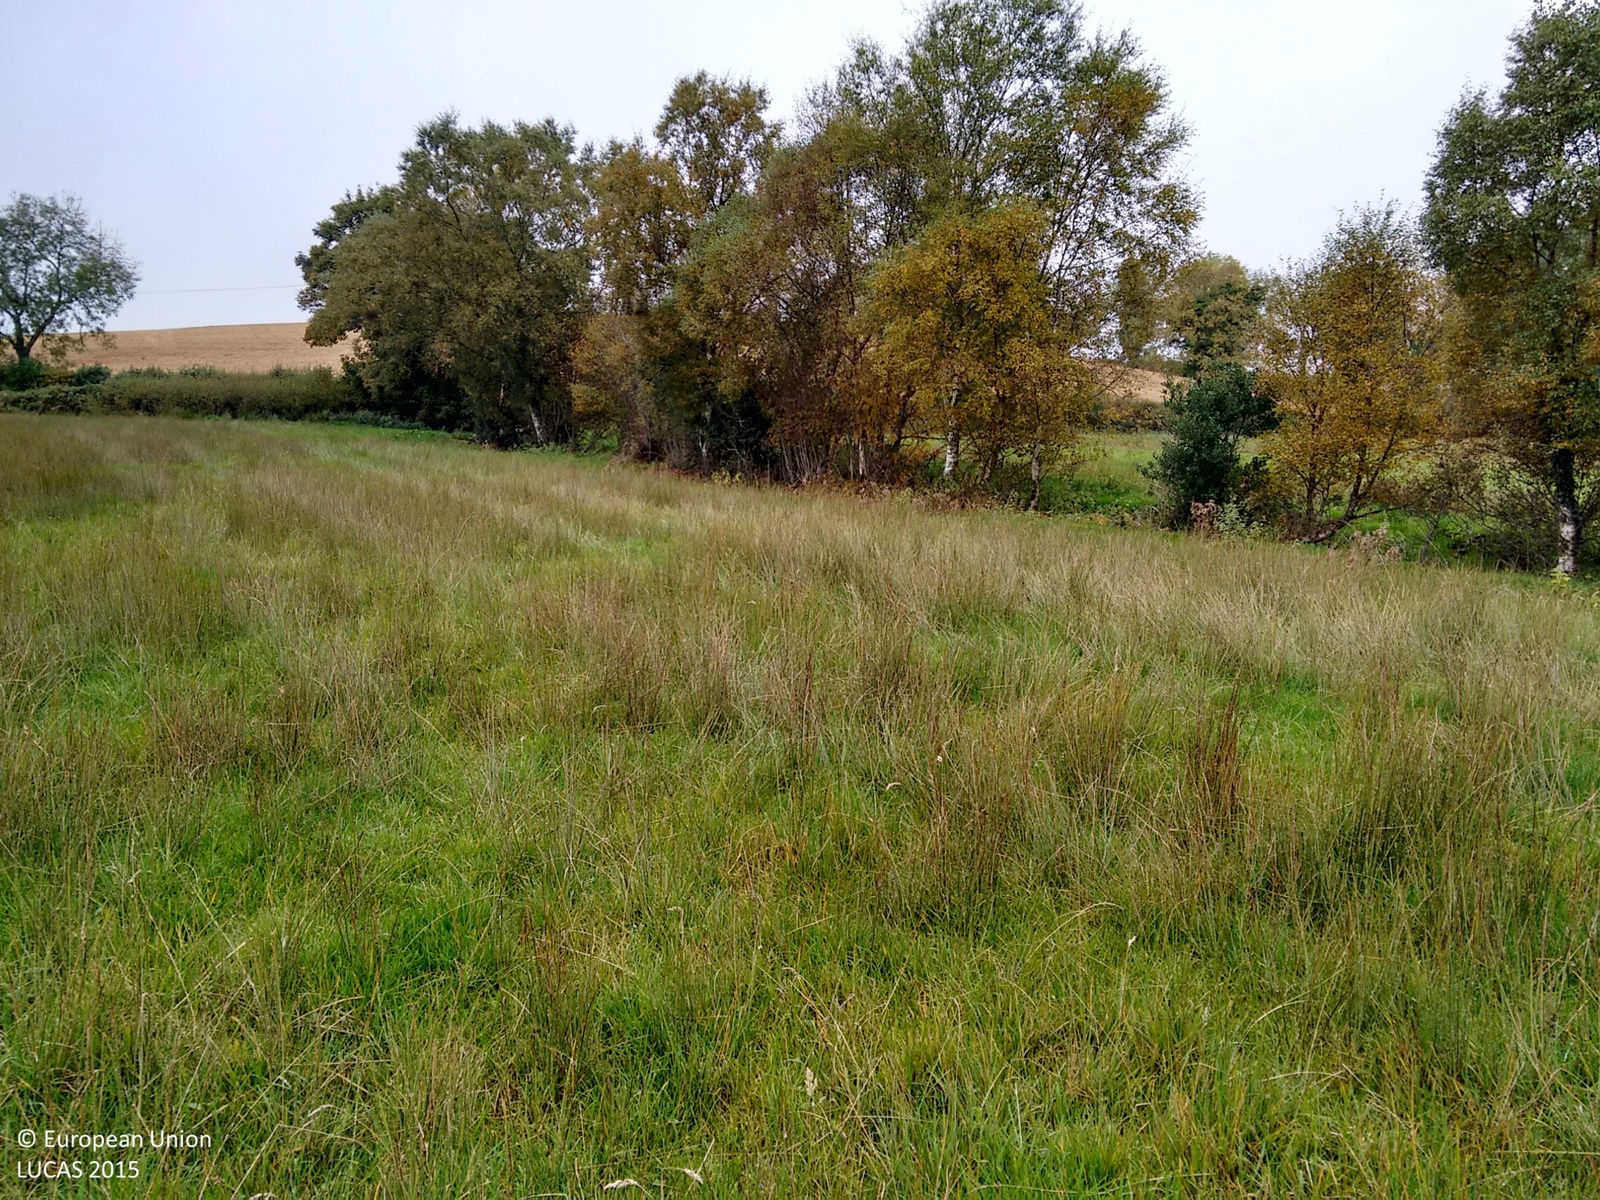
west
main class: Grassland
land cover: Grassland without tree/shrub cover
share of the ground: > 75 %
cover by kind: herbaceous plants 100 %
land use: Agriculture (excluding fallow land and kitchen gardens)
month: October
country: GB
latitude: 54.6479
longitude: -7.4327
